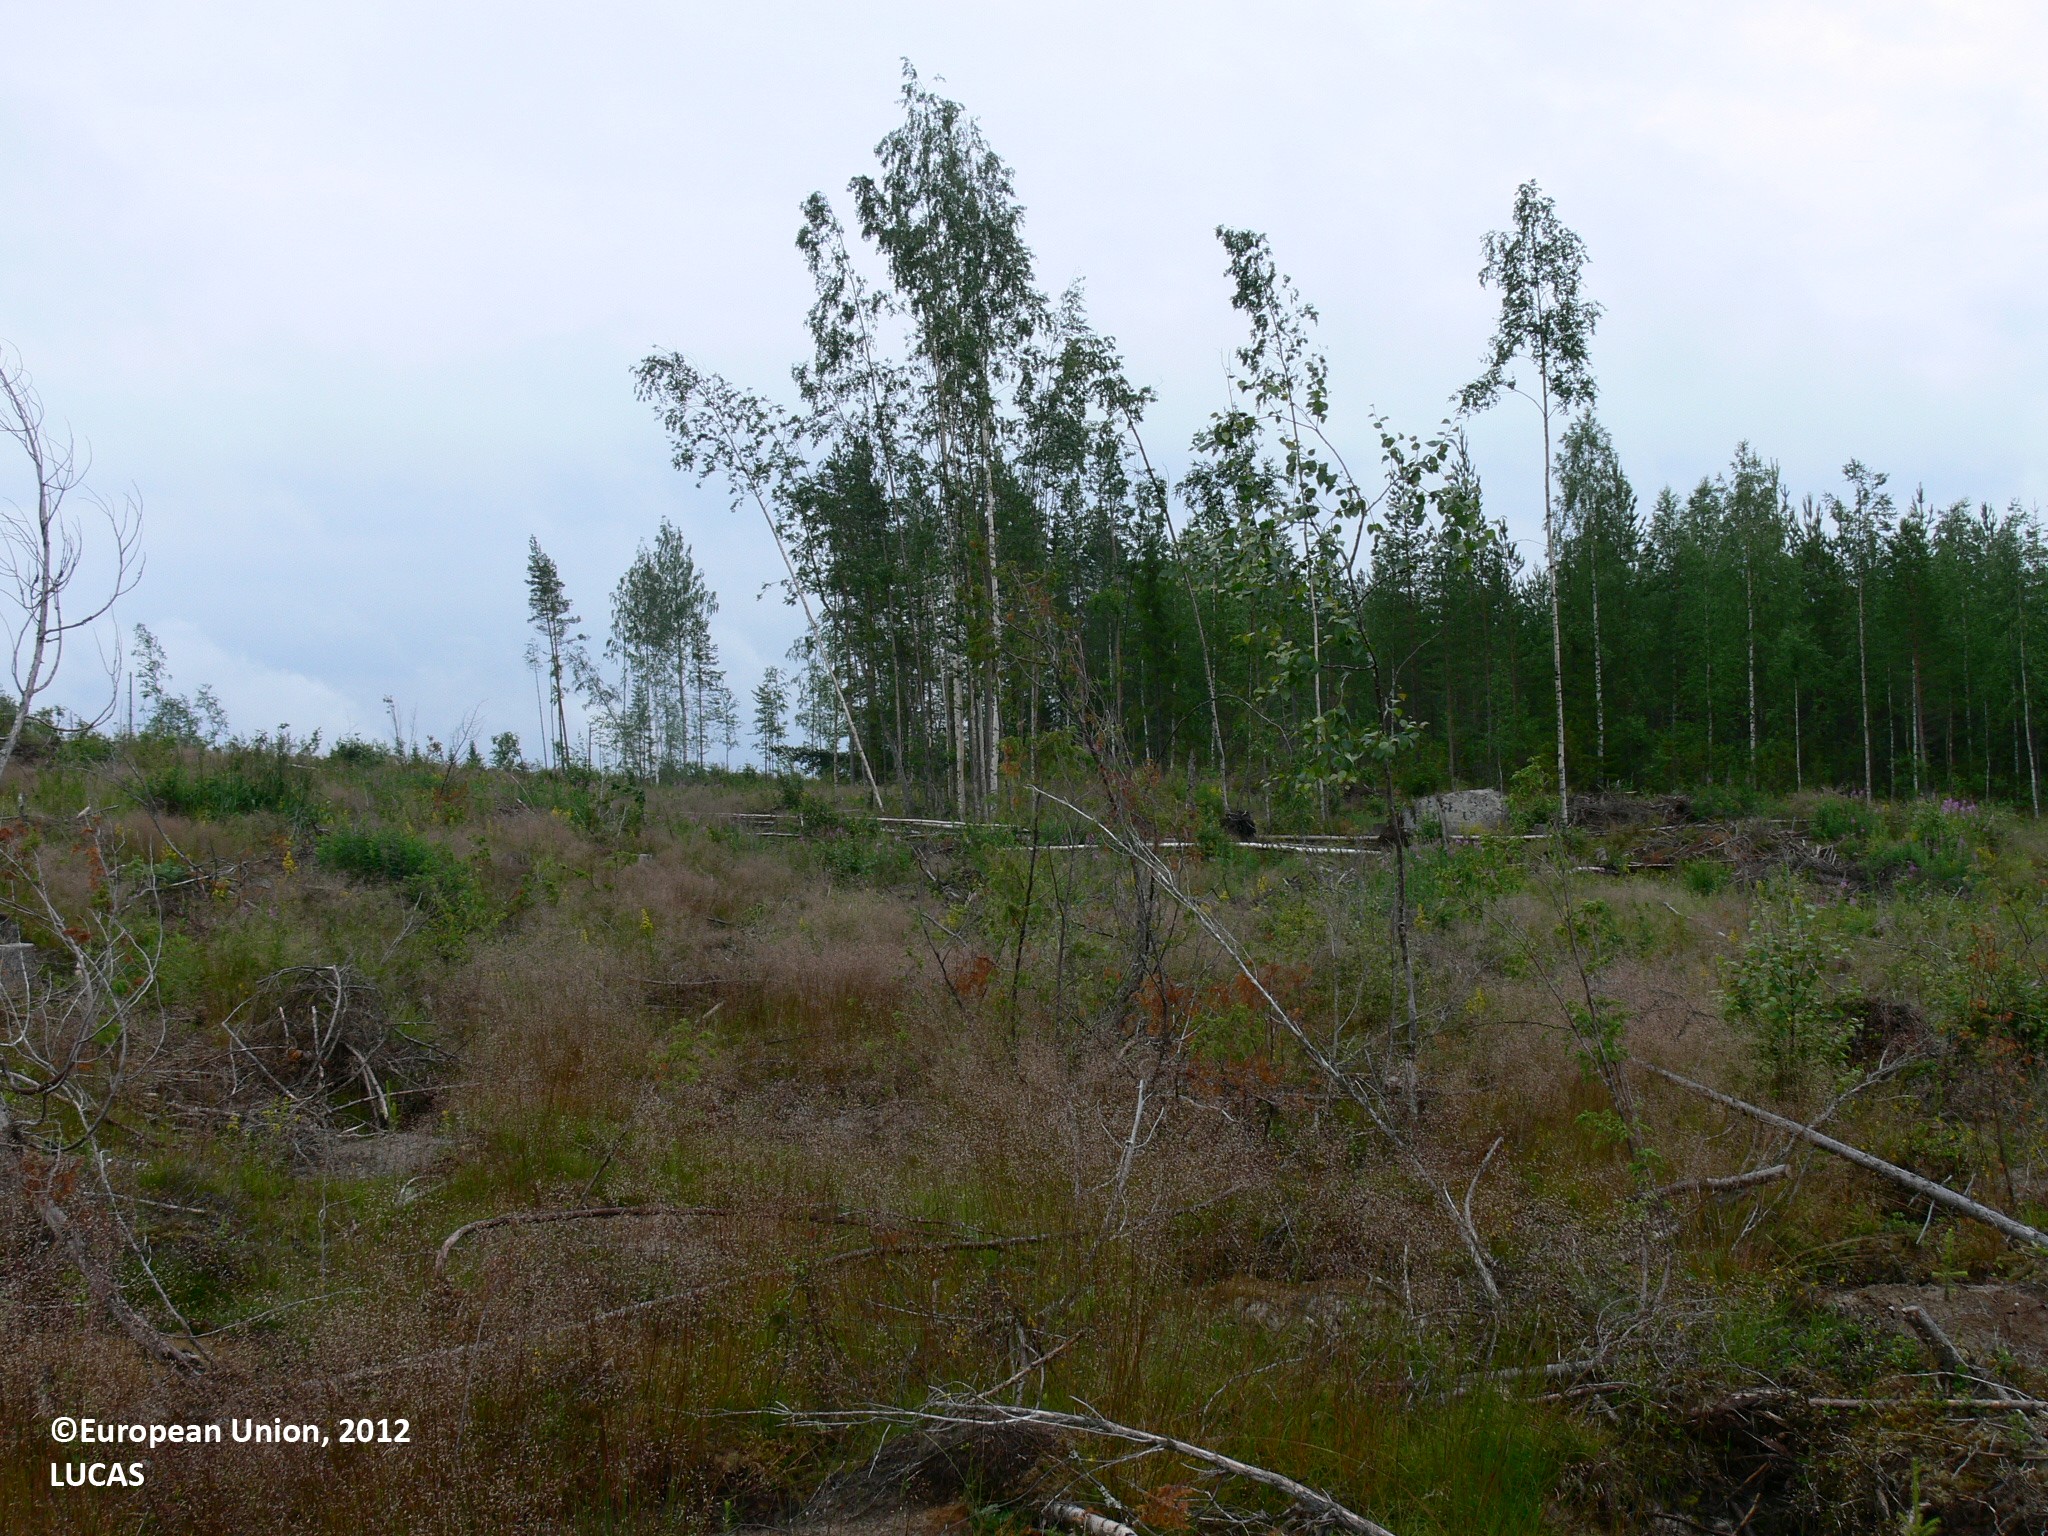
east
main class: Woodland
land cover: Pine dominated coniferous woodland
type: boreal forest
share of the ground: < 10 %
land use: Forestry
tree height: < 5 m
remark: Clear cut
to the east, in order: Pine dominated coniferous woodland; Pine dominated mixed woodland; Grass margins; Ditches and canals; Grass margins; Paved roads, cycling and walking lanes; Grass margins; Ditches and canals; Shruby margins; Broadleaved woodland
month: July
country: FI
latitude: 63.1512
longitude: 30.8721
